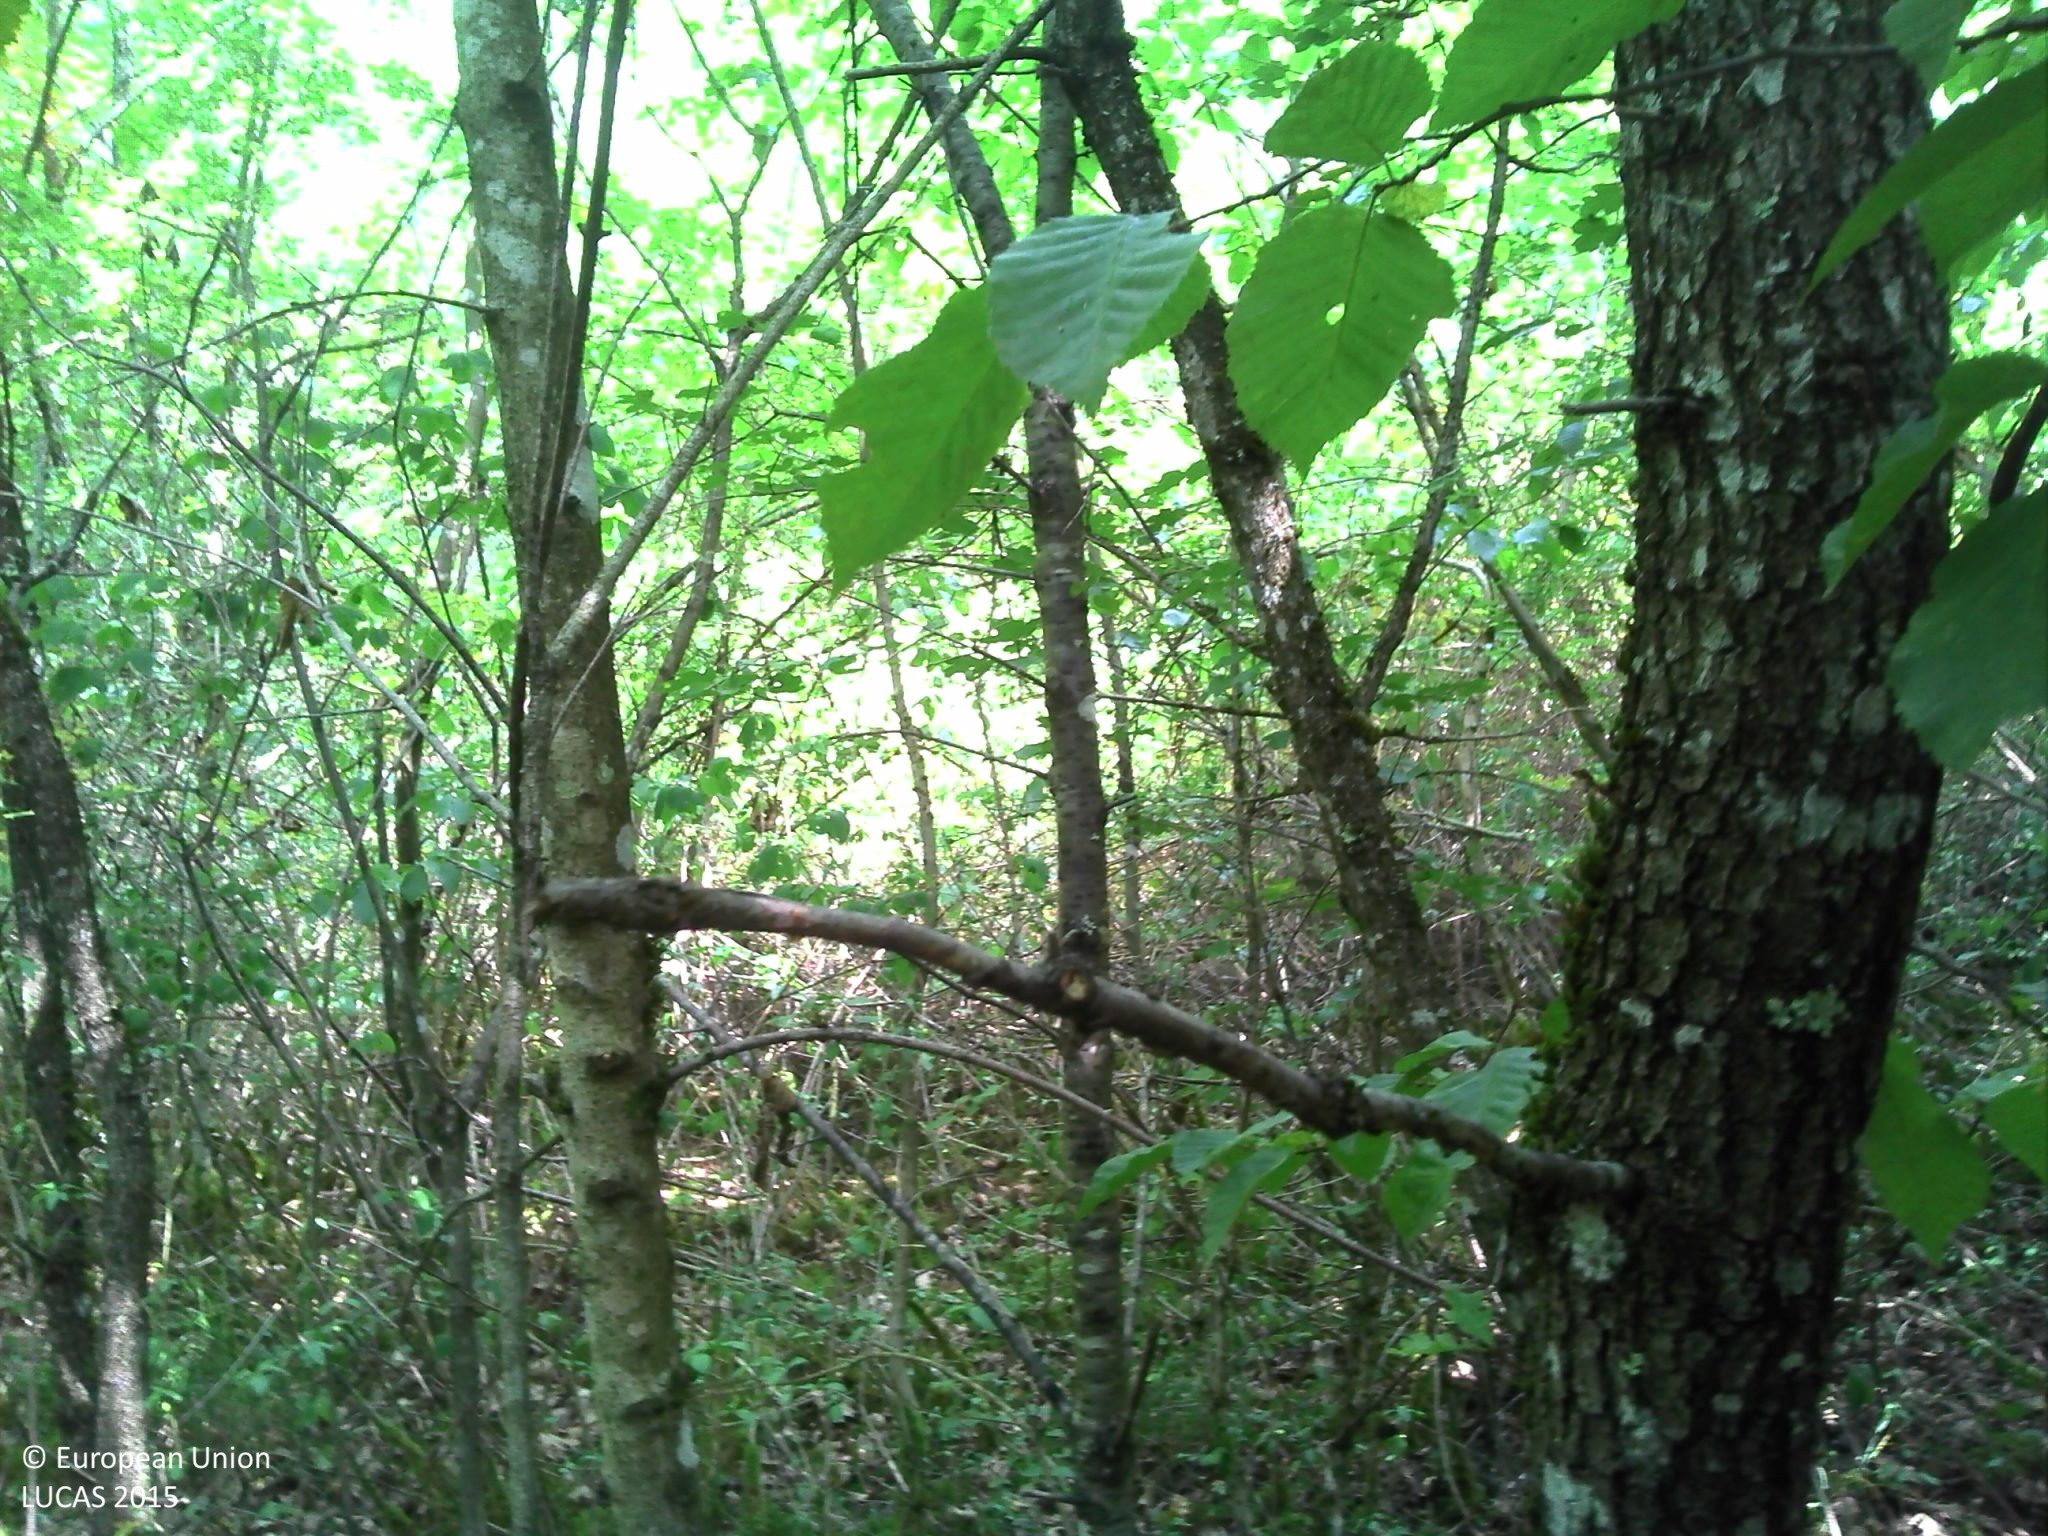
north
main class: Woodland
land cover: Broadleaved woodland
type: mesophytic deciduous forest
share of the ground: > 75 %
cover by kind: broadleaved forest trees 85 %, lichens and mosses 10 %, herbaceous plants 5 %
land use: Forestry
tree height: > 5 m
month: July
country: FR
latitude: 45.6578
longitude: 5.4227
